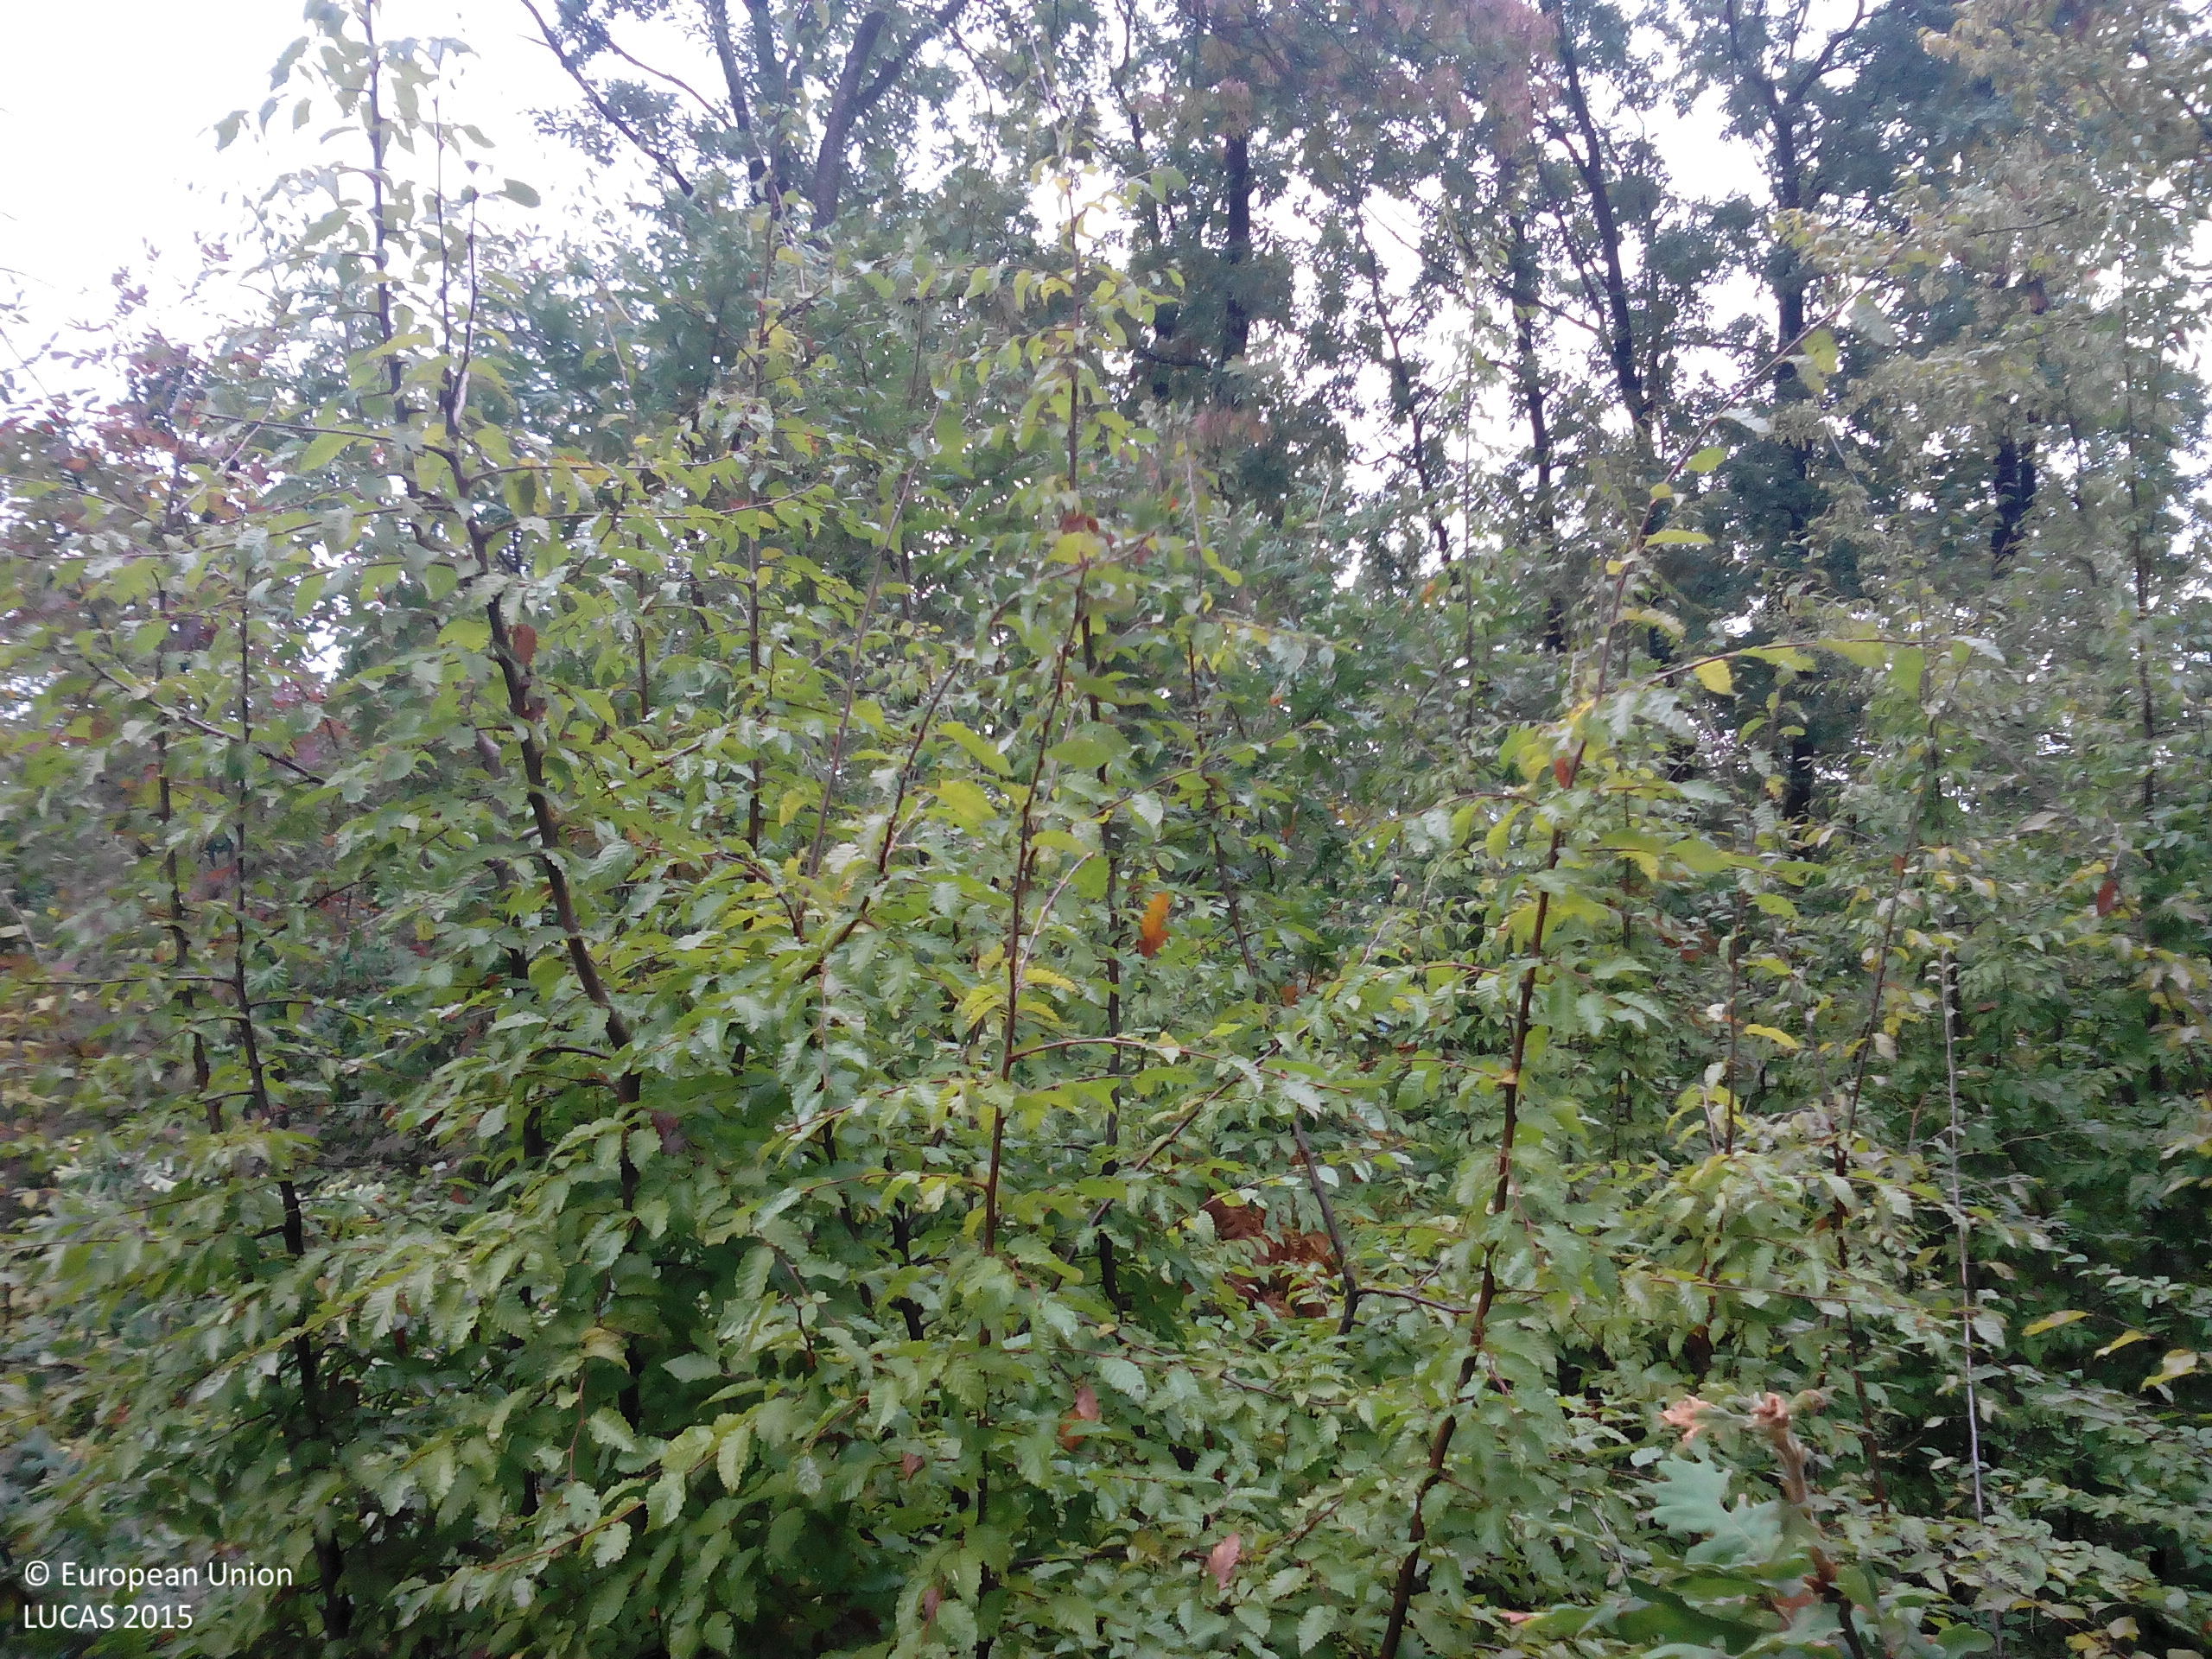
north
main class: Woodland
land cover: Broadleaved woodland
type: acidophilous oak and oak-birch forest
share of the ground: > 75 %
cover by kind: broadleaved forest trees 90 %, shrubs 5 %, herbaceous plants 5 %
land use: Forestry
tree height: > 5 m
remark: Clear cut
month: October
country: BG
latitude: 43.1151
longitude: 24.0478
